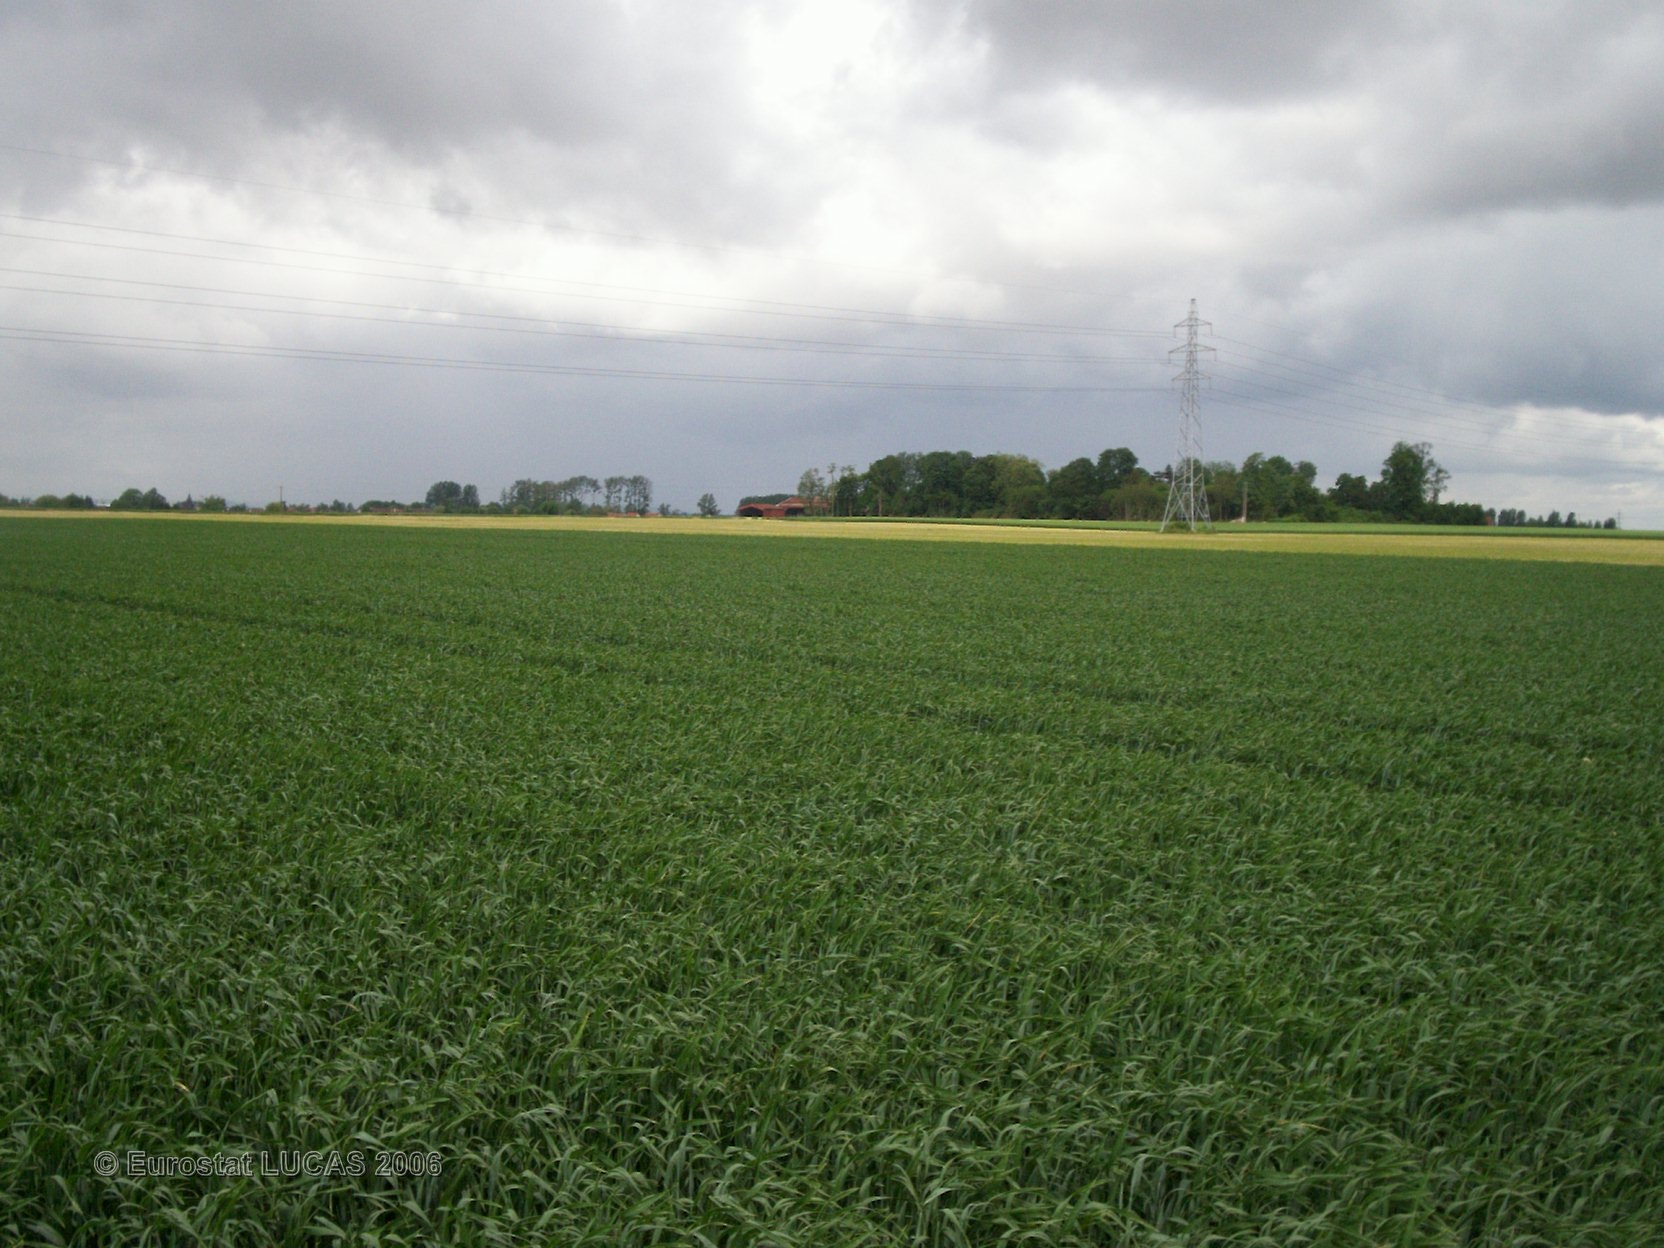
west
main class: Cropland
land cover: Common wheat
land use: Agriculture (excluding fallow land and kitchen gardens)
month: May
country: FR
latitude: 49.5935
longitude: 3.6711
